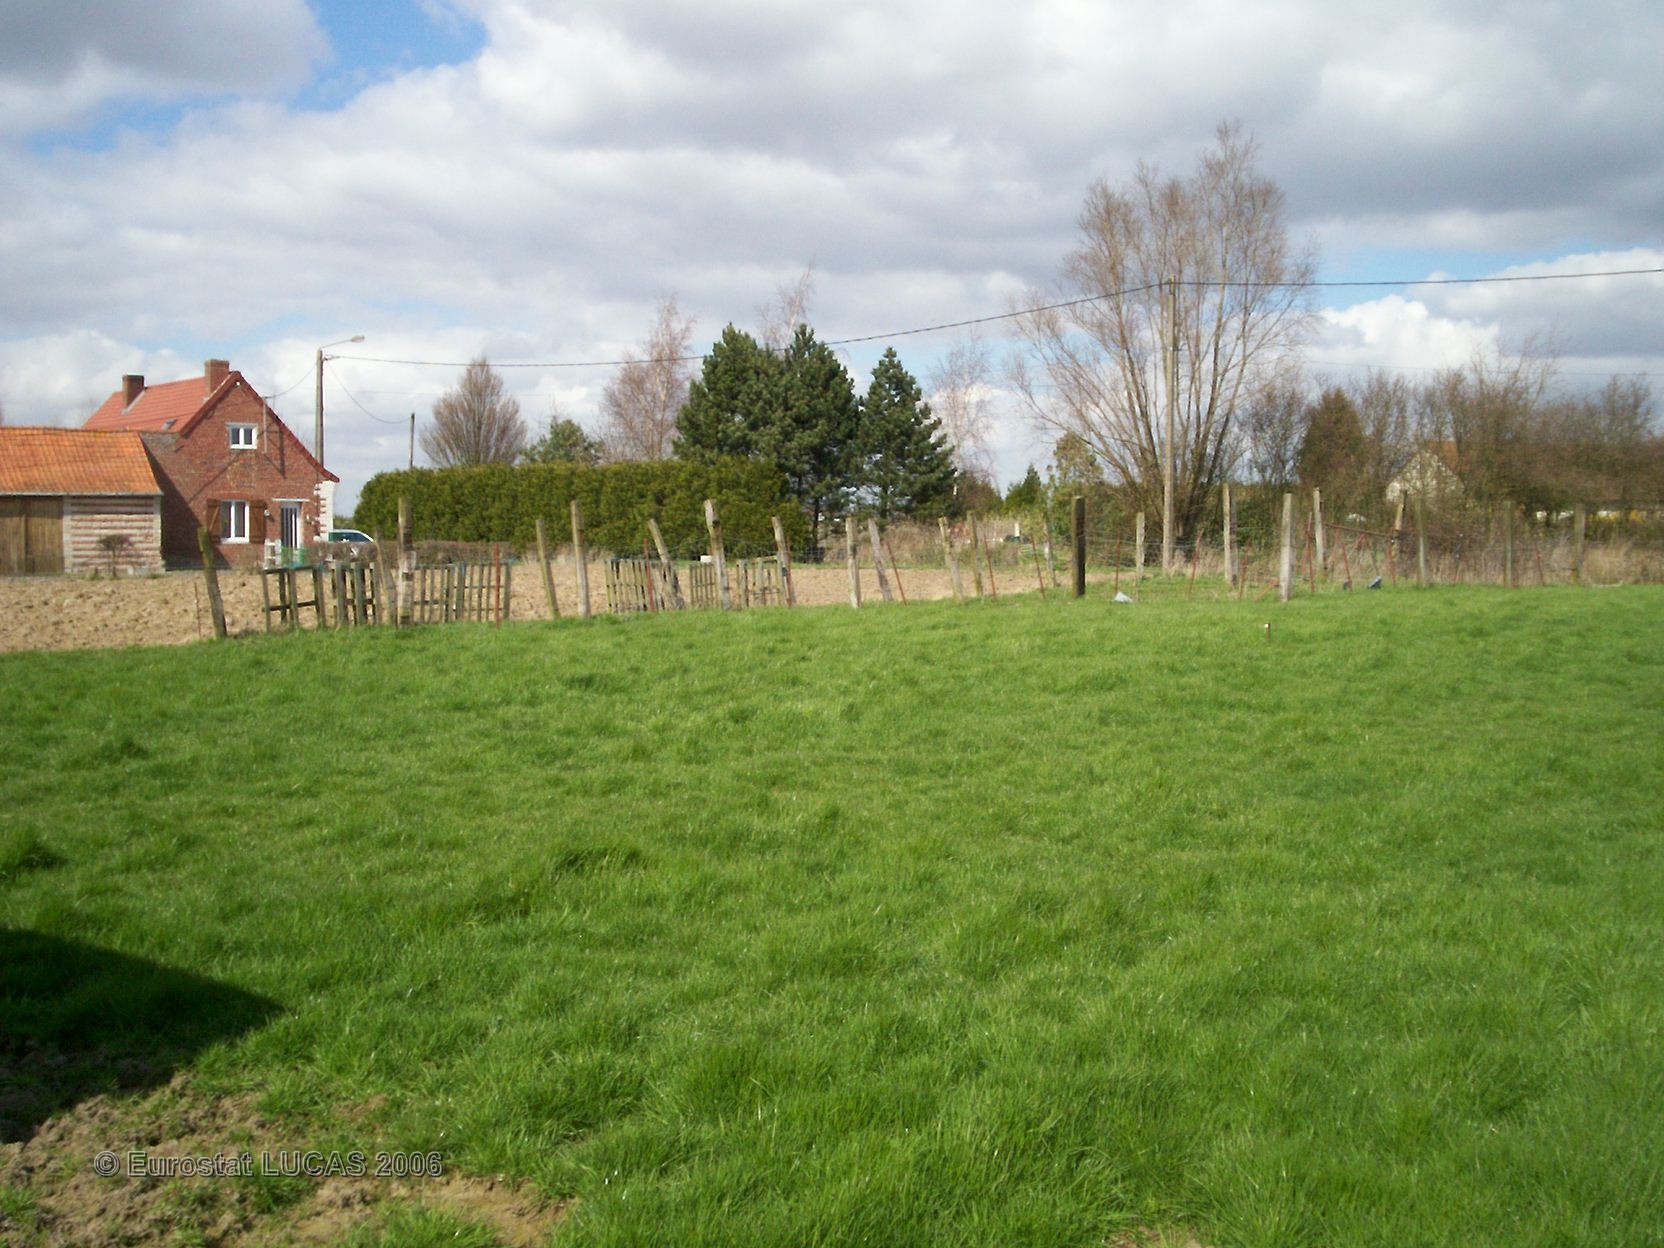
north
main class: Grassland
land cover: Grassland without tree/shrub cover
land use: Agriculture (excluding fallow land and kitchen gardens)
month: April
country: FR
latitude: 50.5937
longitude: 2.5998
